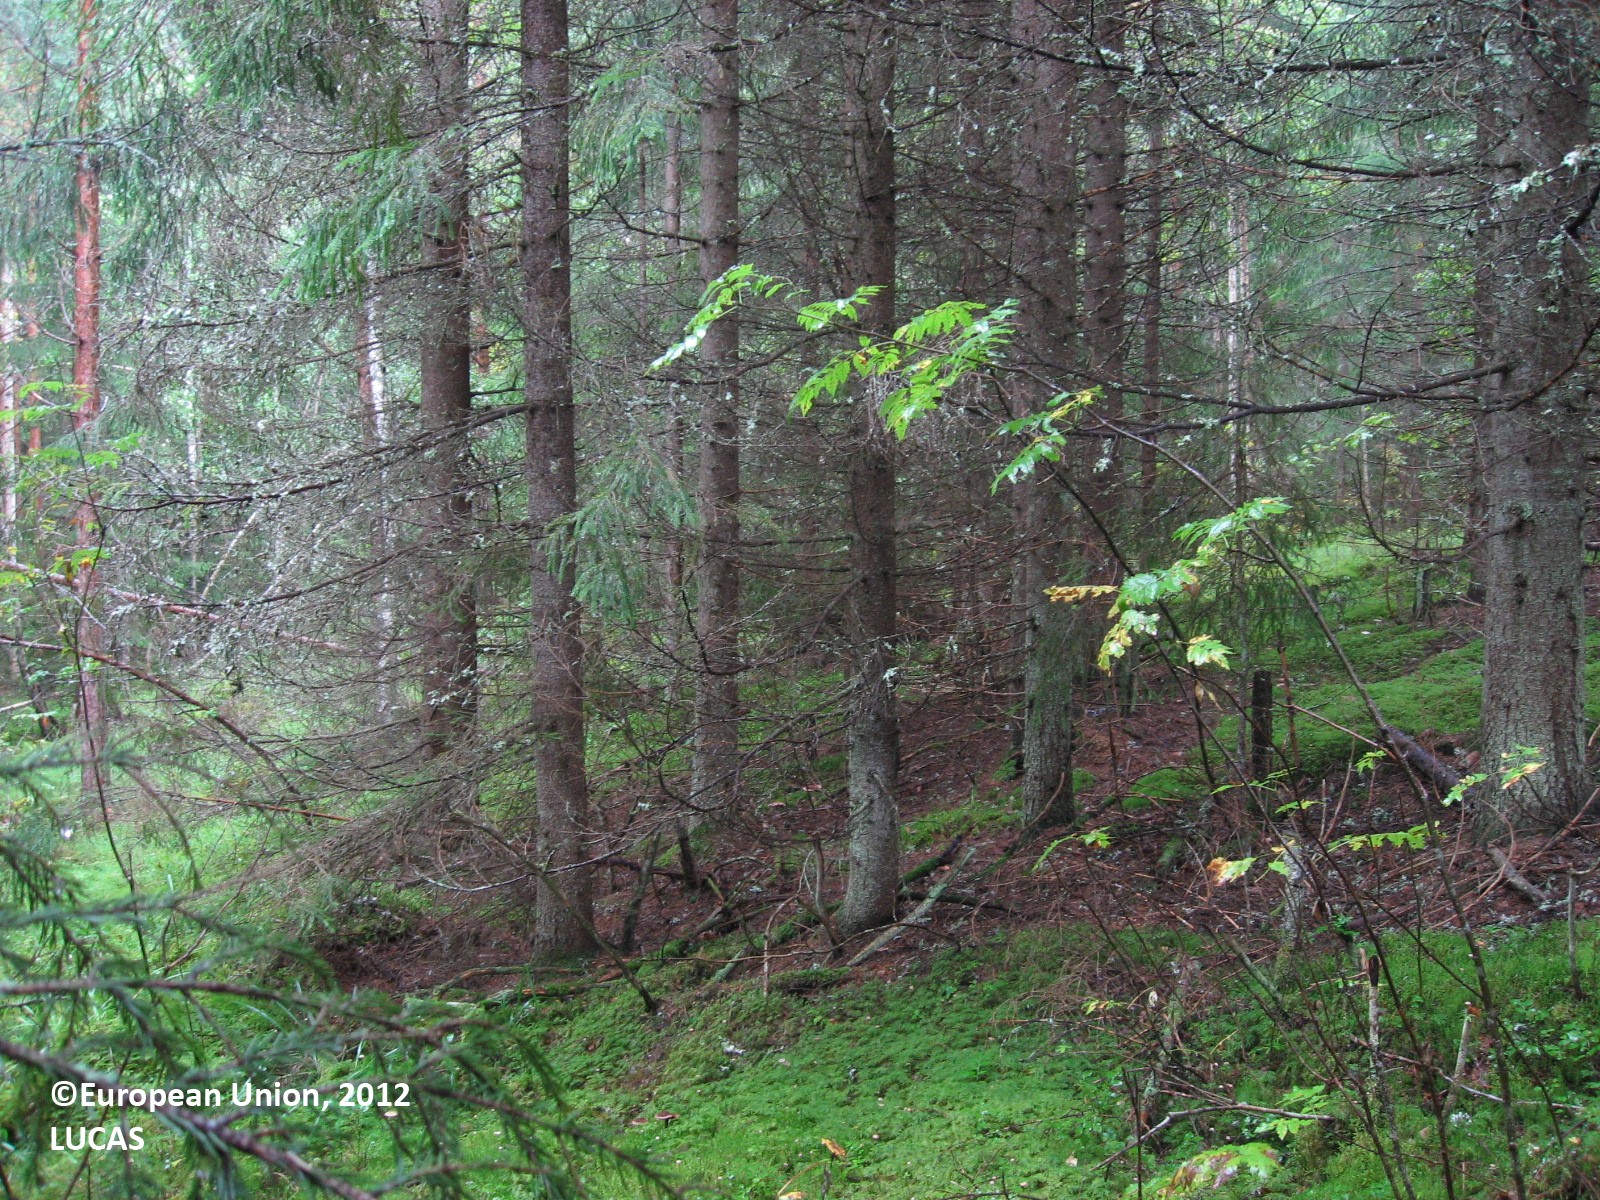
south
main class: Woodland
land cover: Spruce dominated mixed woodland
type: boreal forest
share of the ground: > 75 %
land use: Forestry
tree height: > 5 m
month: August
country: FI
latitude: 60.7220
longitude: 25.0942
